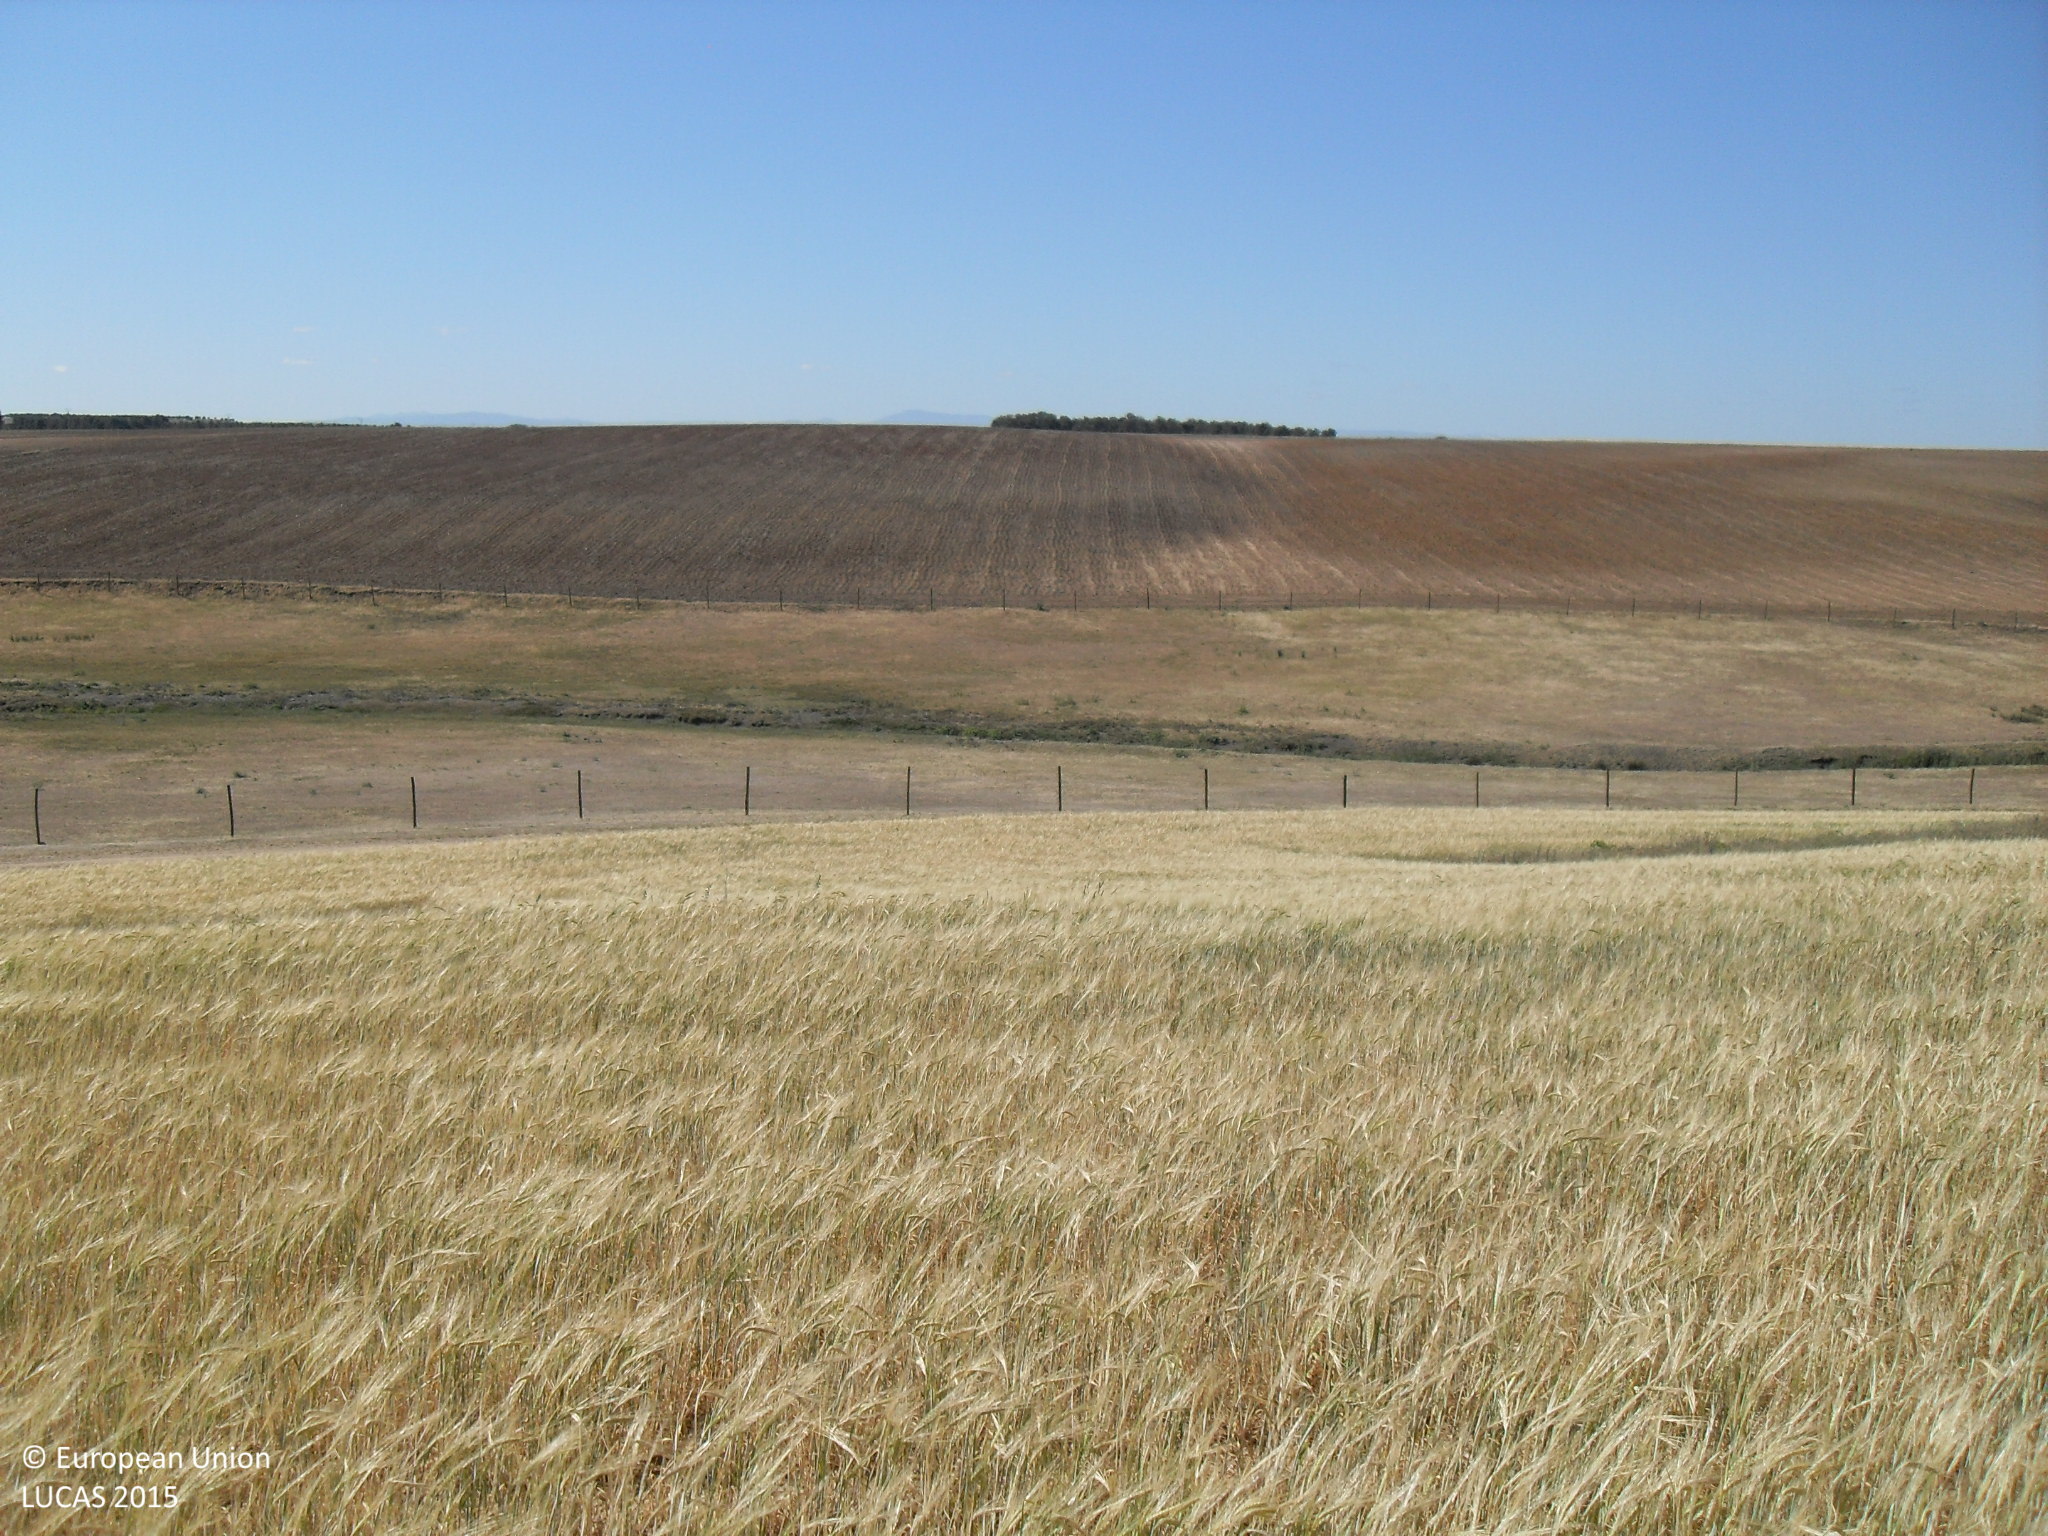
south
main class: Cropland
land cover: Barley
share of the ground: > 75 %
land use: Agriculture (excluding fallow land and kitchen gardens)
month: May
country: ES
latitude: 41.1585
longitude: -5.2666
